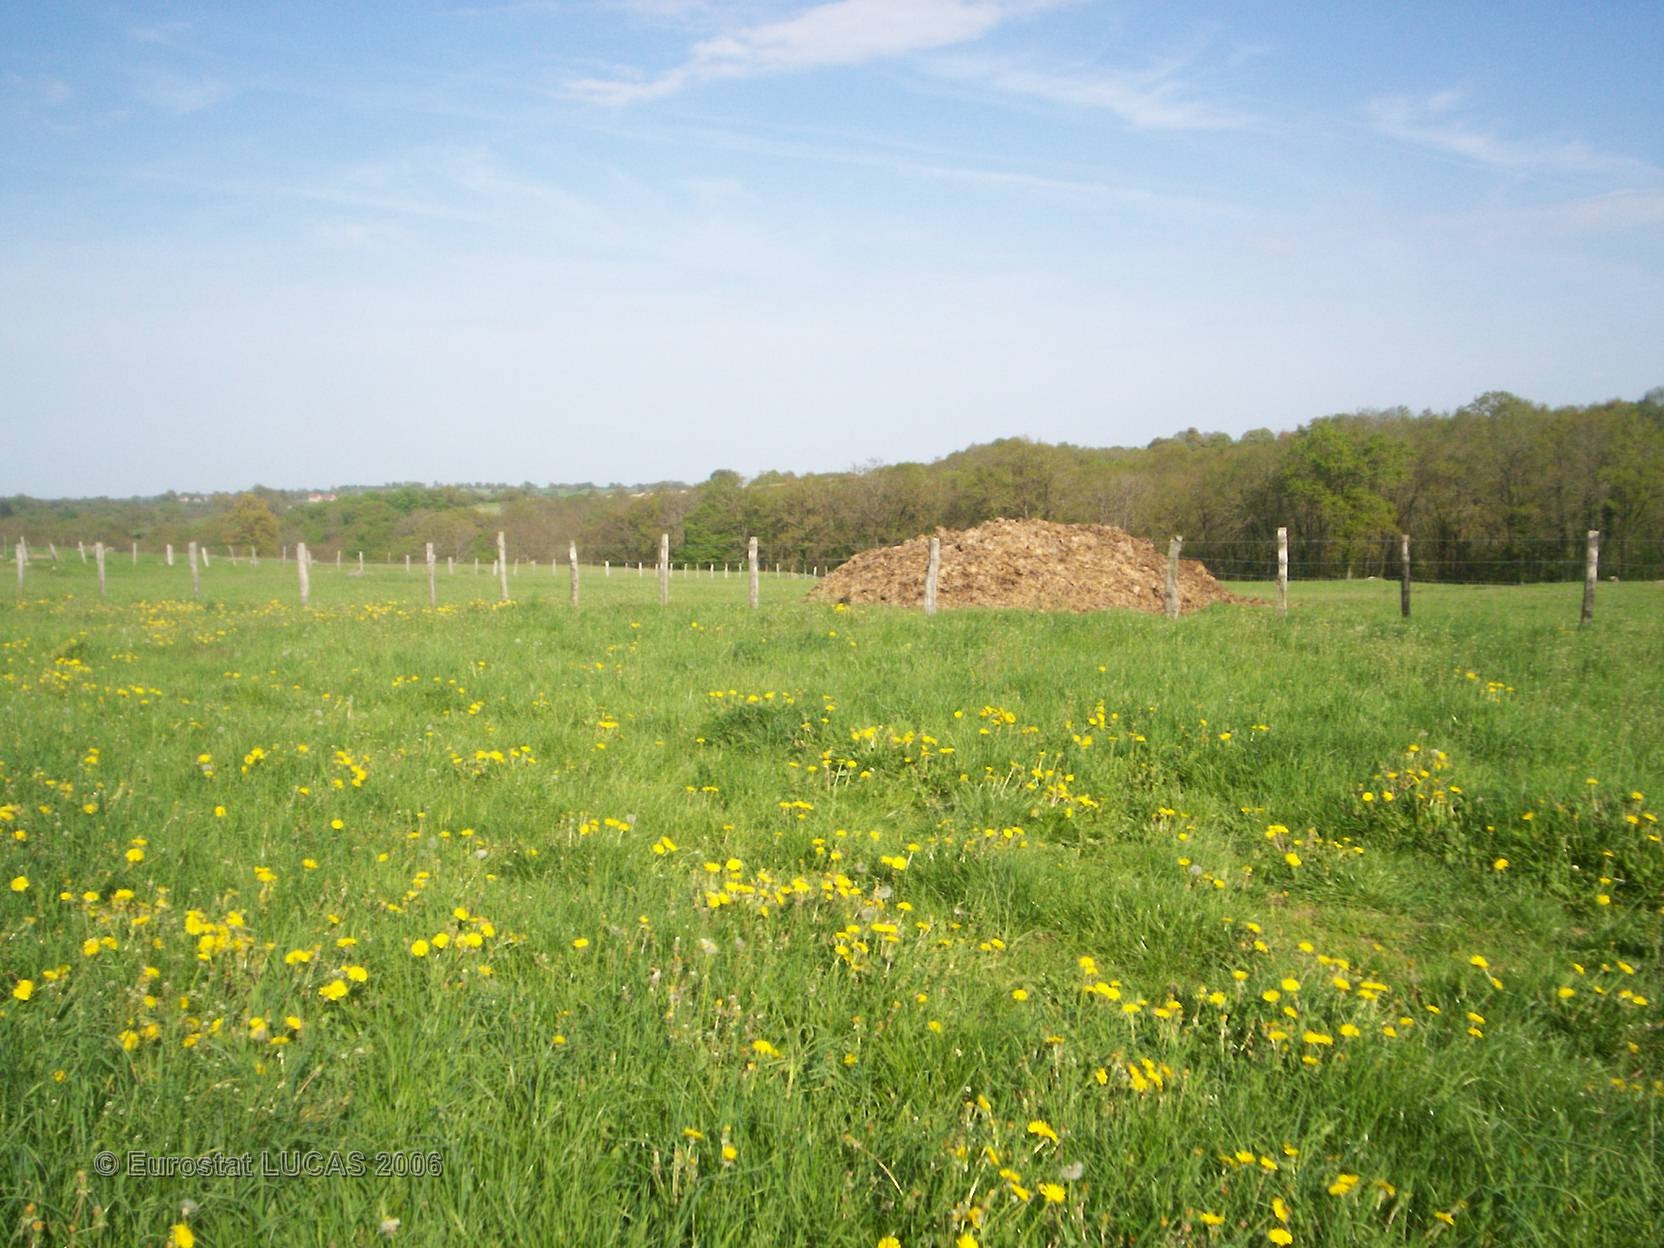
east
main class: Grassland
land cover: Grassland without tree/shrub cover
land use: Agriculture (excluding fallow land and kitchen gardens)
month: May
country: FR
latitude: 46.2504
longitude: 3.0326
